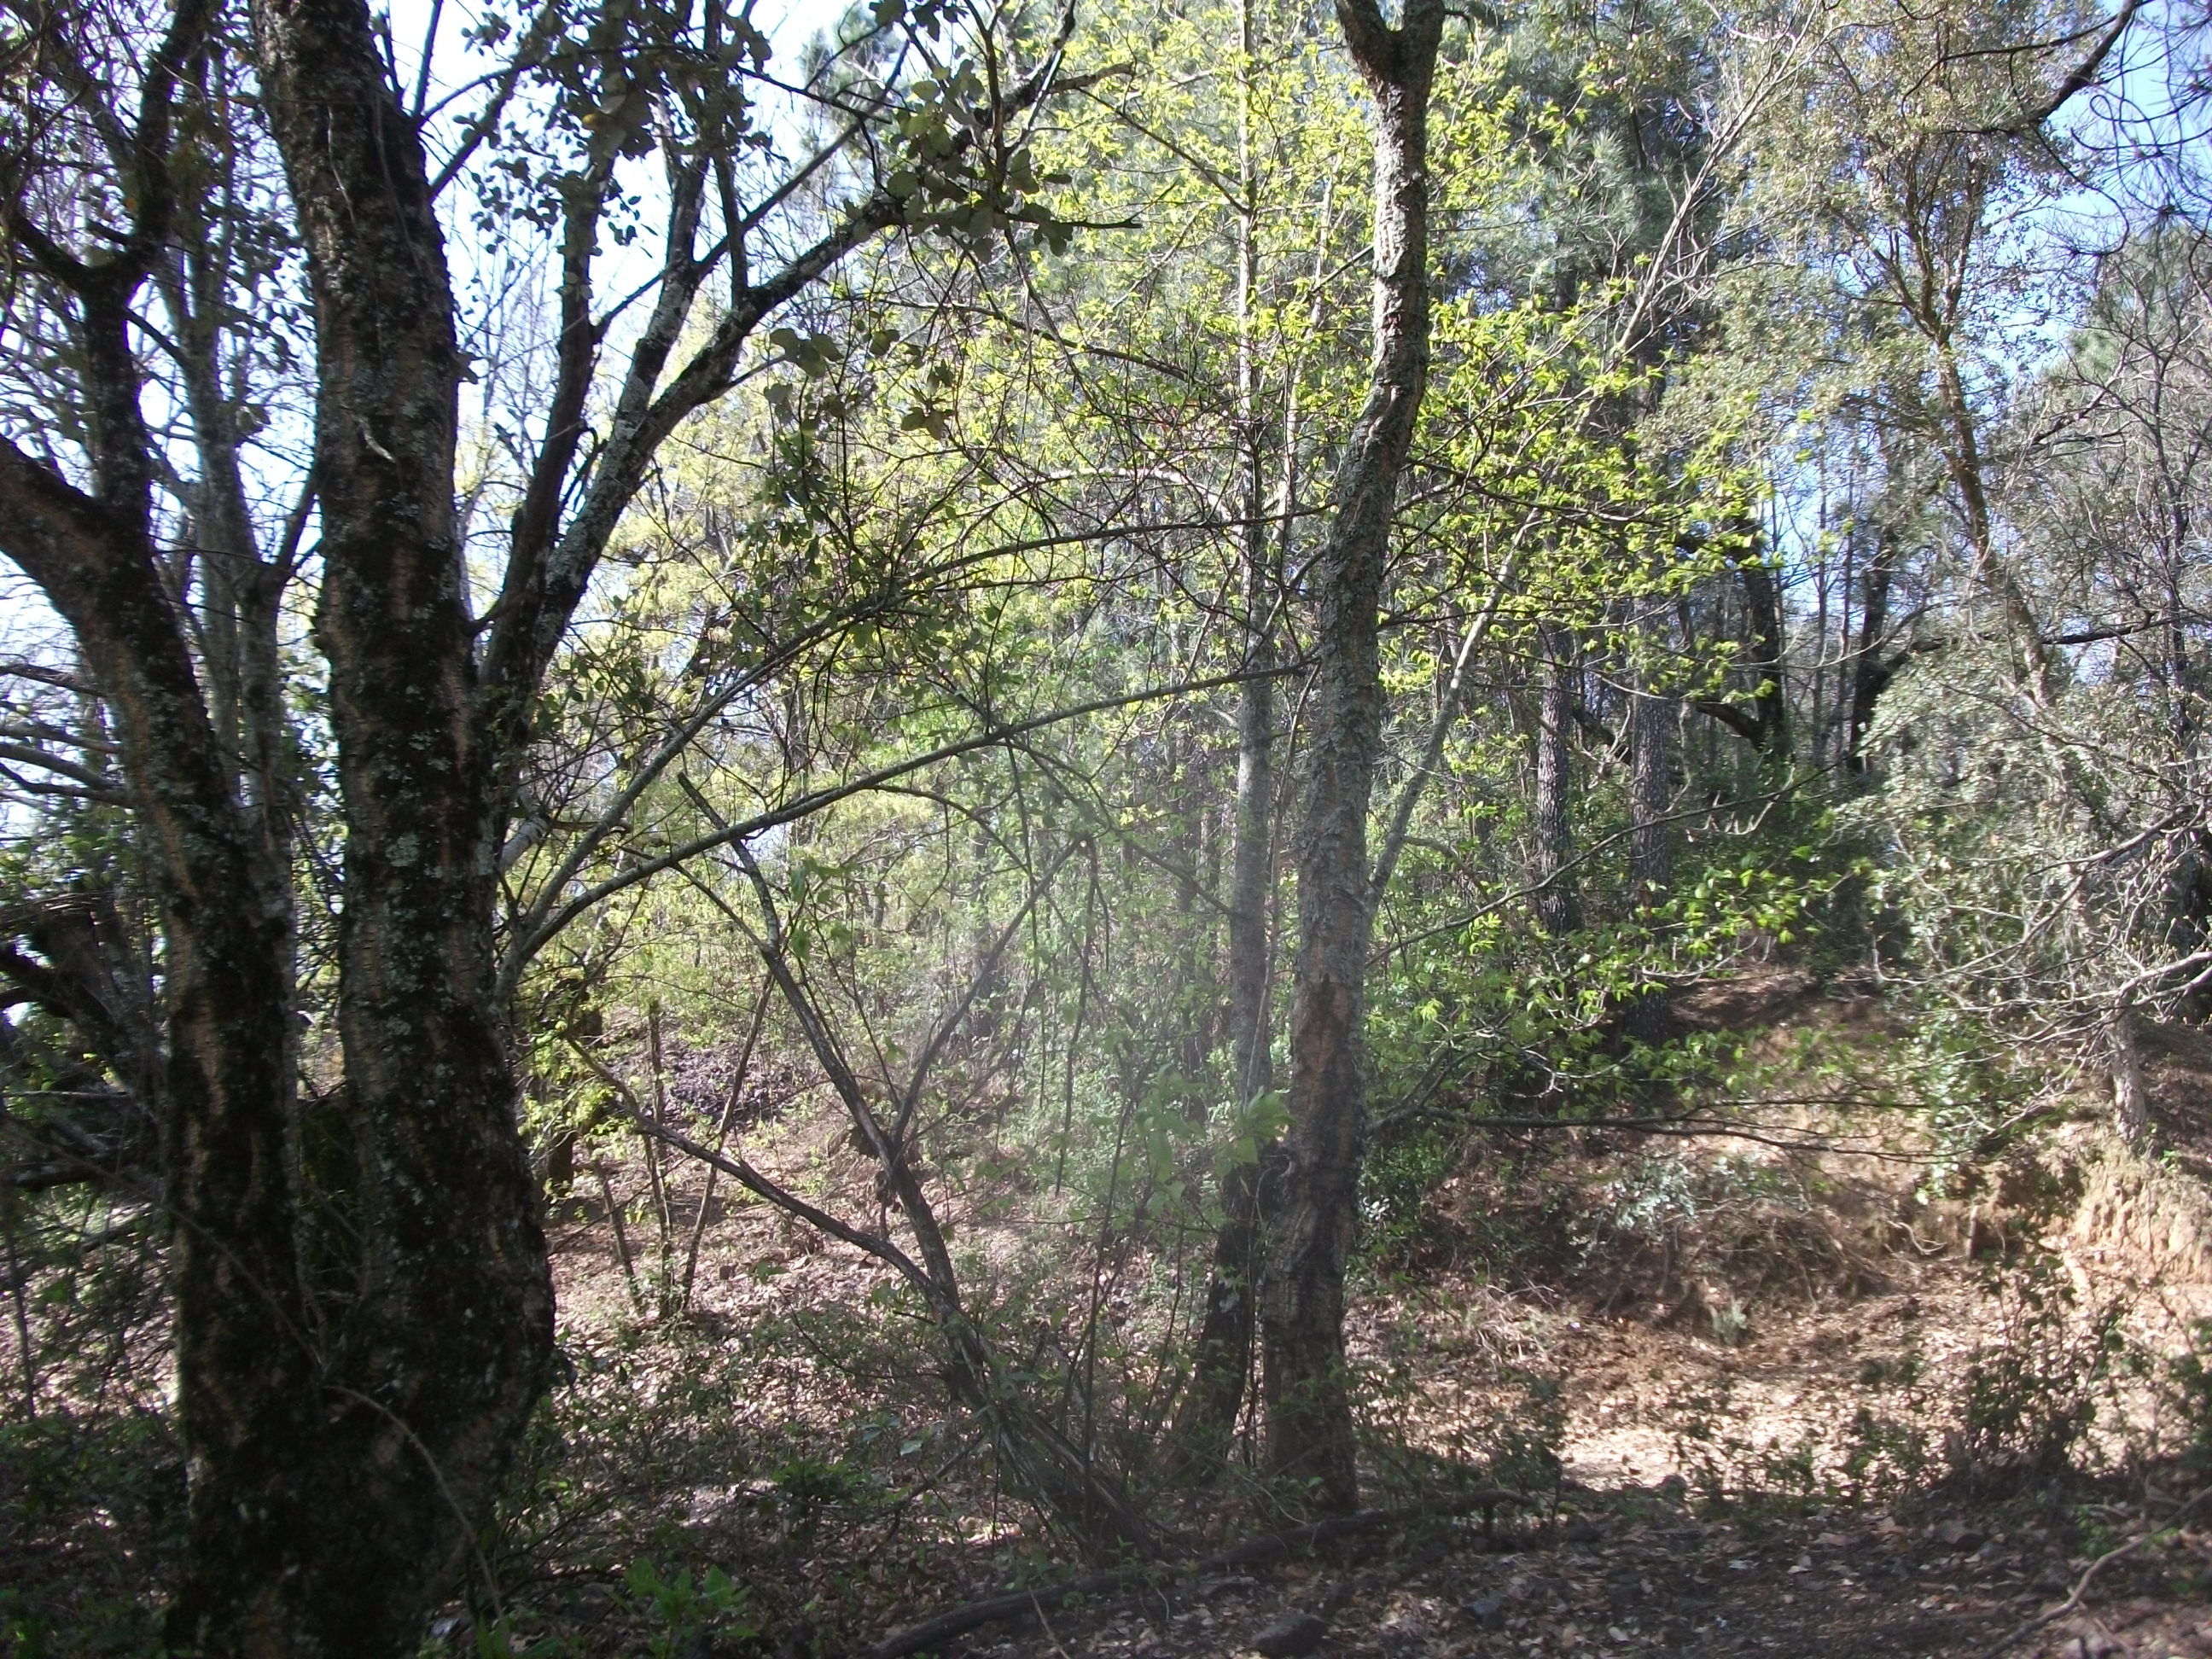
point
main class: Woodland
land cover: Broadleaved woodland
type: broadleaved evergreen forest
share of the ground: > 75 %
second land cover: Spontaneously vegetated surfaces
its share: < 10 %
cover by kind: broadleaved forest trees 95 %, herbaceous plants 5 %
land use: Forestry
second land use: Agriculture (excluding fallow land and kitchen gardens)
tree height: > 5 m
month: April
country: ES
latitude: 37.9149
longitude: -6.7339
